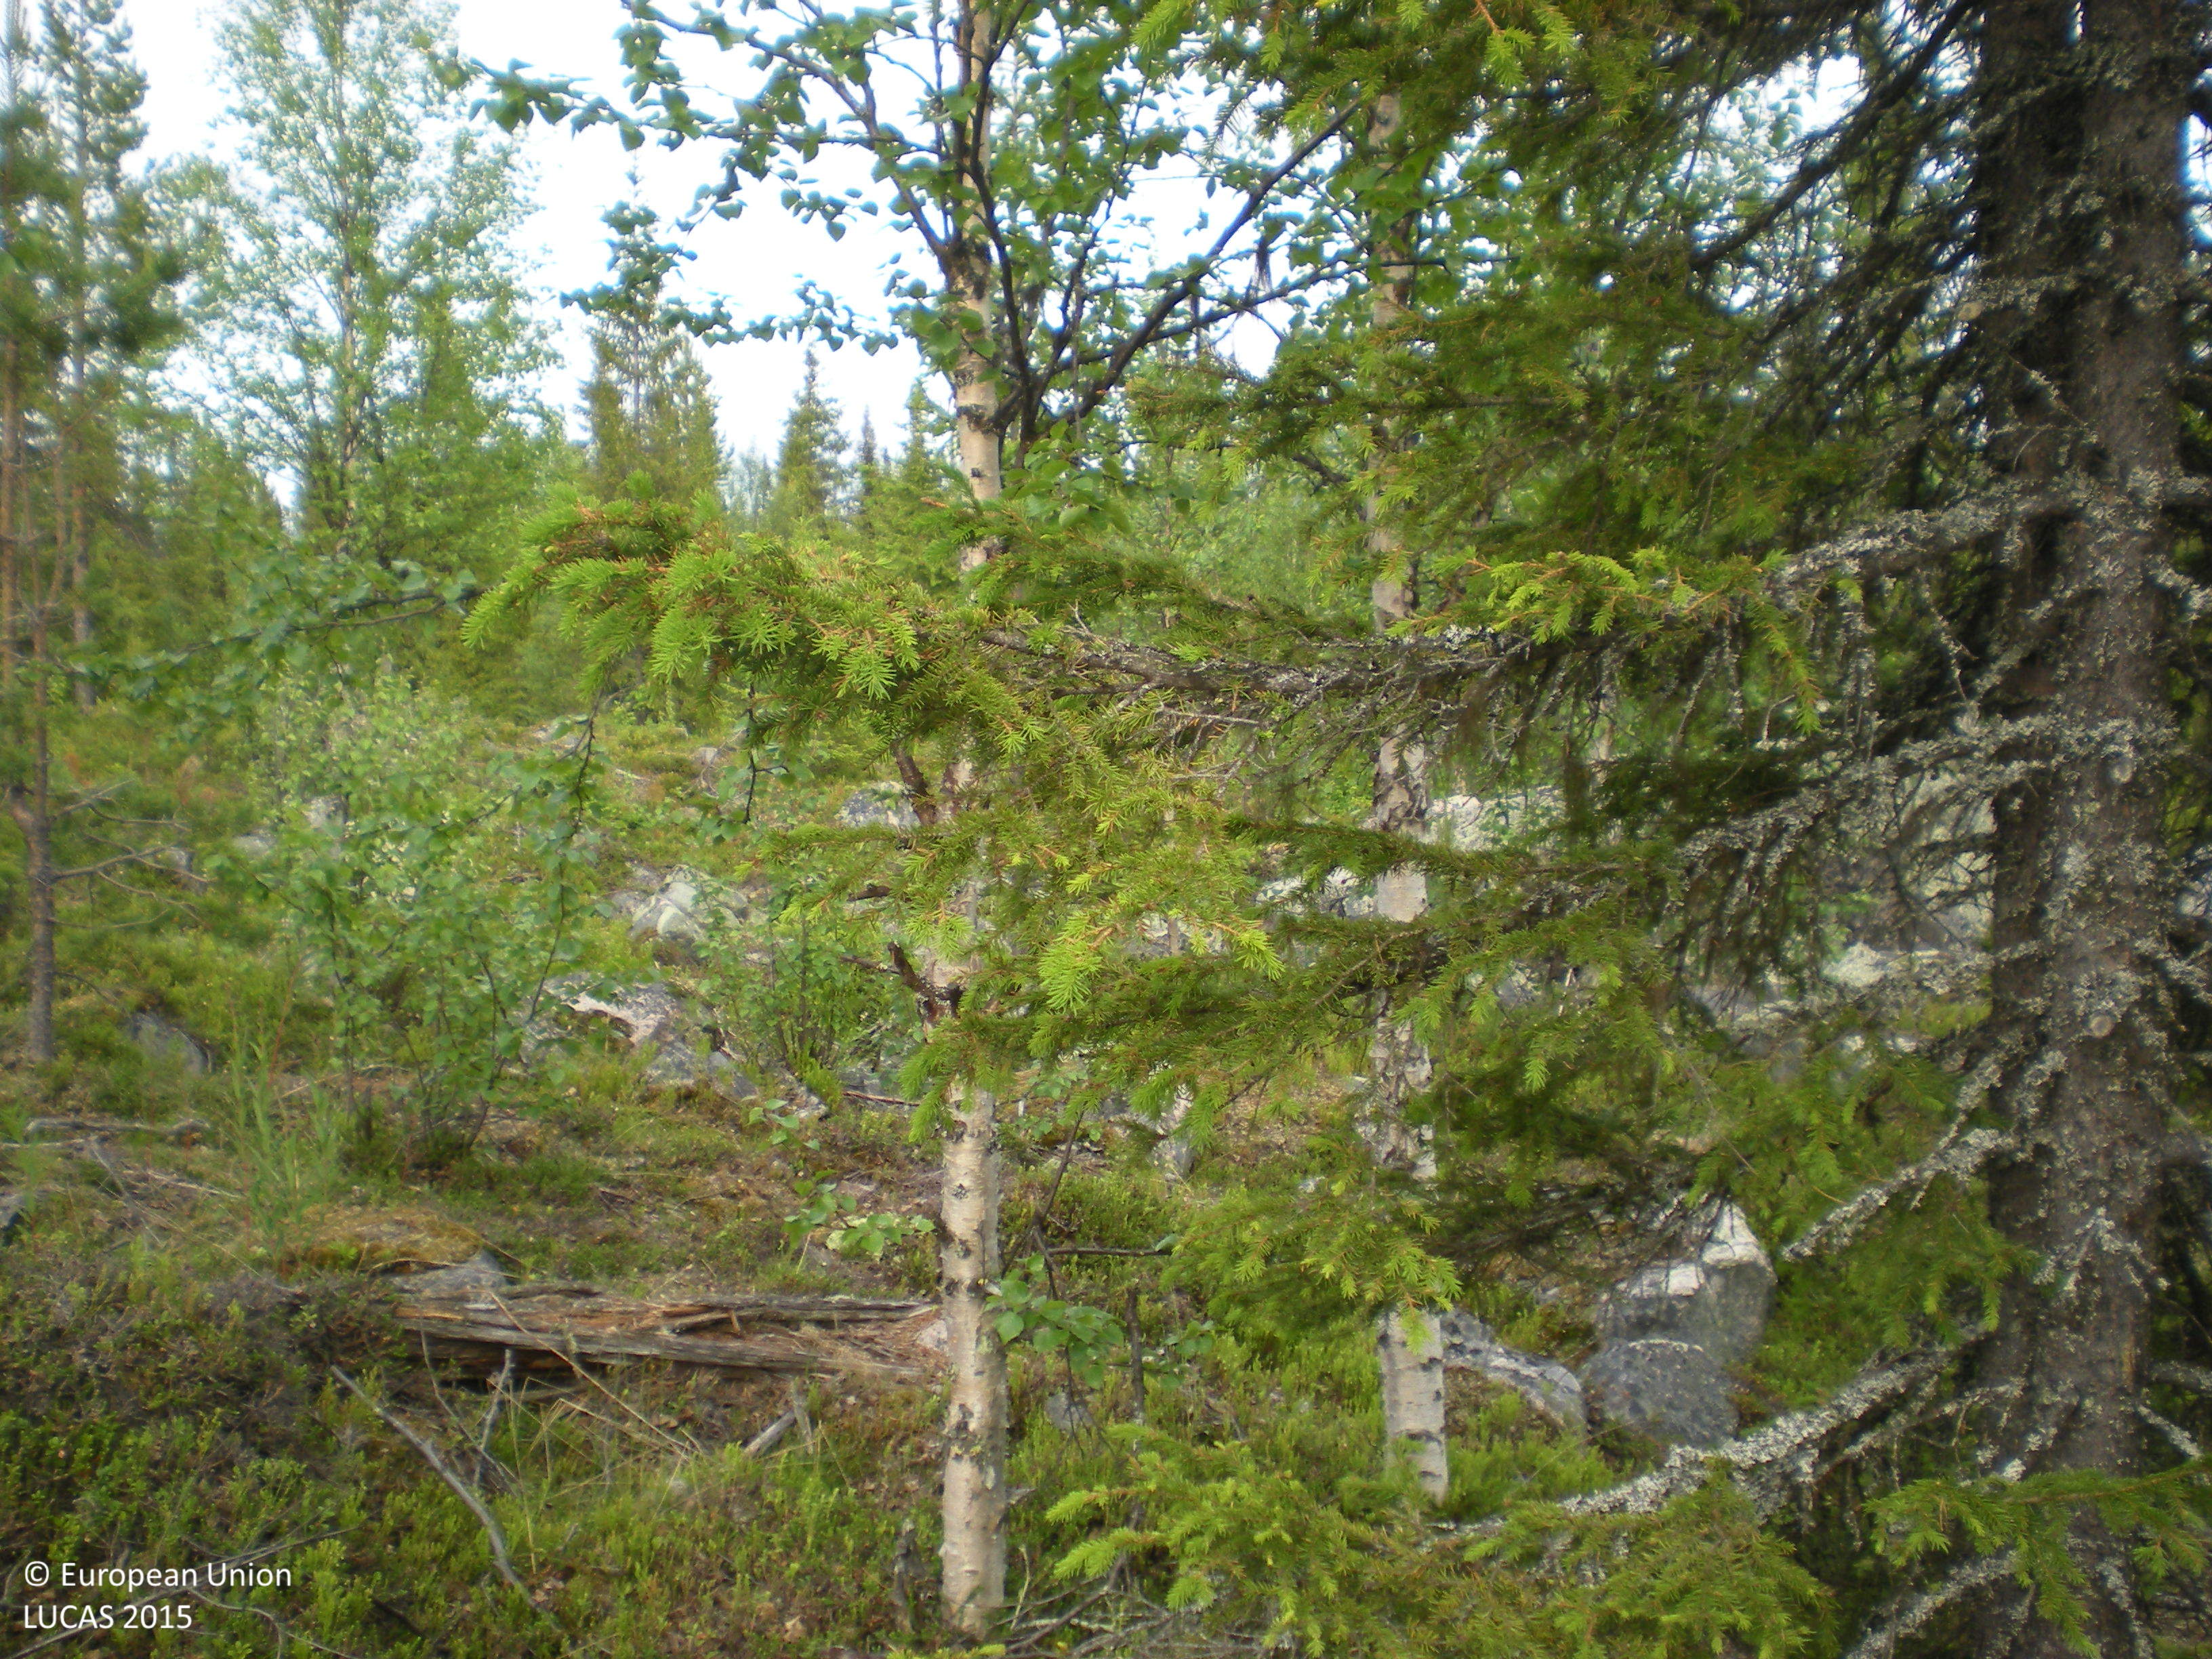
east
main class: Woodland
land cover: Other mixed woodland
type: boreal forest
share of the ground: 50 - 75 %
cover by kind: coniferous forest trees 40 %, shrubs 30 %, broadleaved forest trees 15 %, lichens and mosses 10 %, consolidated bare surface 5 %
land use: Forestry
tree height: > 5 m
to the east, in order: Other mixed woodland; Spruce dominated mixed woodland; Inland fresh water bodies; Spruce dominated mixed woodland; Shrubland with sparse tree cover; Paved roads, cycling and walking lanes; Shrubland with sparse tree cover; Spruce dominated mixed woodland; Rocks and stones; Inland fresh running water
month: July
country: SE
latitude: 65.6563
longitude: 17.0686
